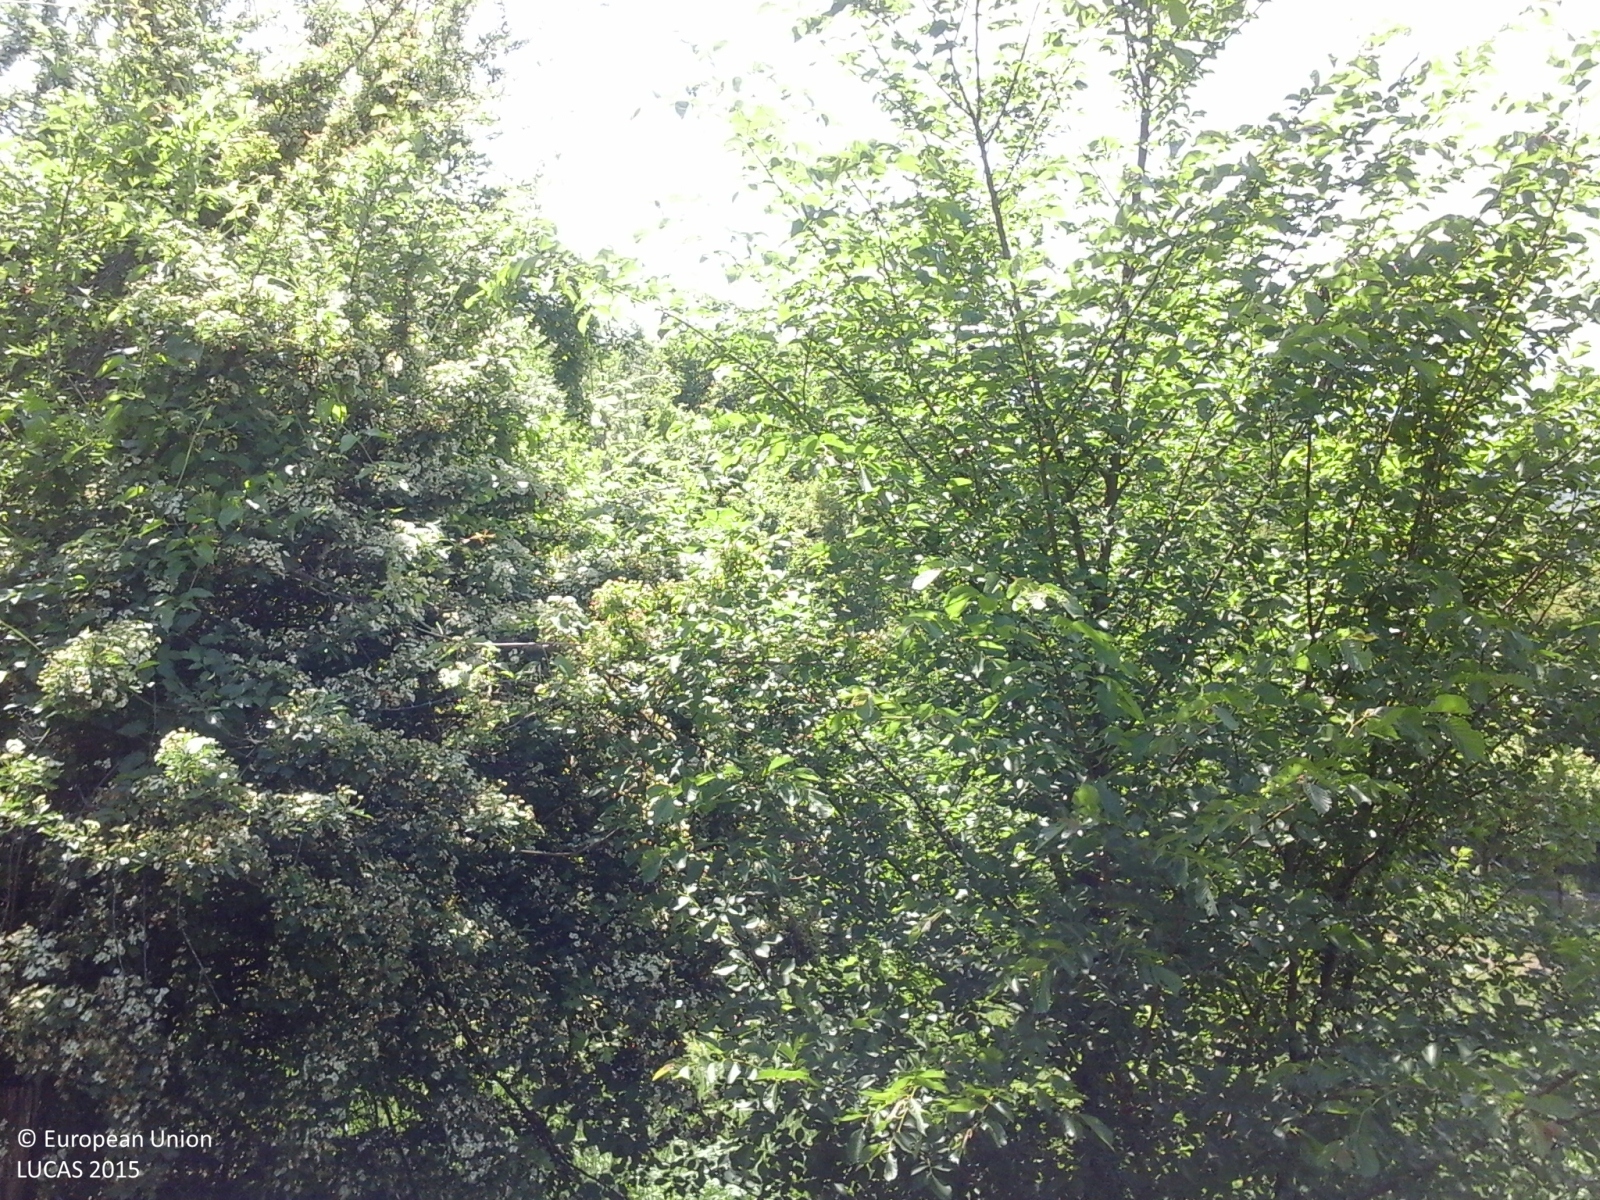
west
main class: Grassland
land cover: Grassland with sparse tree/shrub cover
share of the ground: > 75 %
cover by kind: herbaceous plants 90 %, broadleaved forest trees 5 %, shrubs 5 %
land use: Agriculture (excluding fallow land and kitchen gardens)
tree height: > 5 m
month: May
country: IT
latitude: 44.7646
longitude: 9.6092
